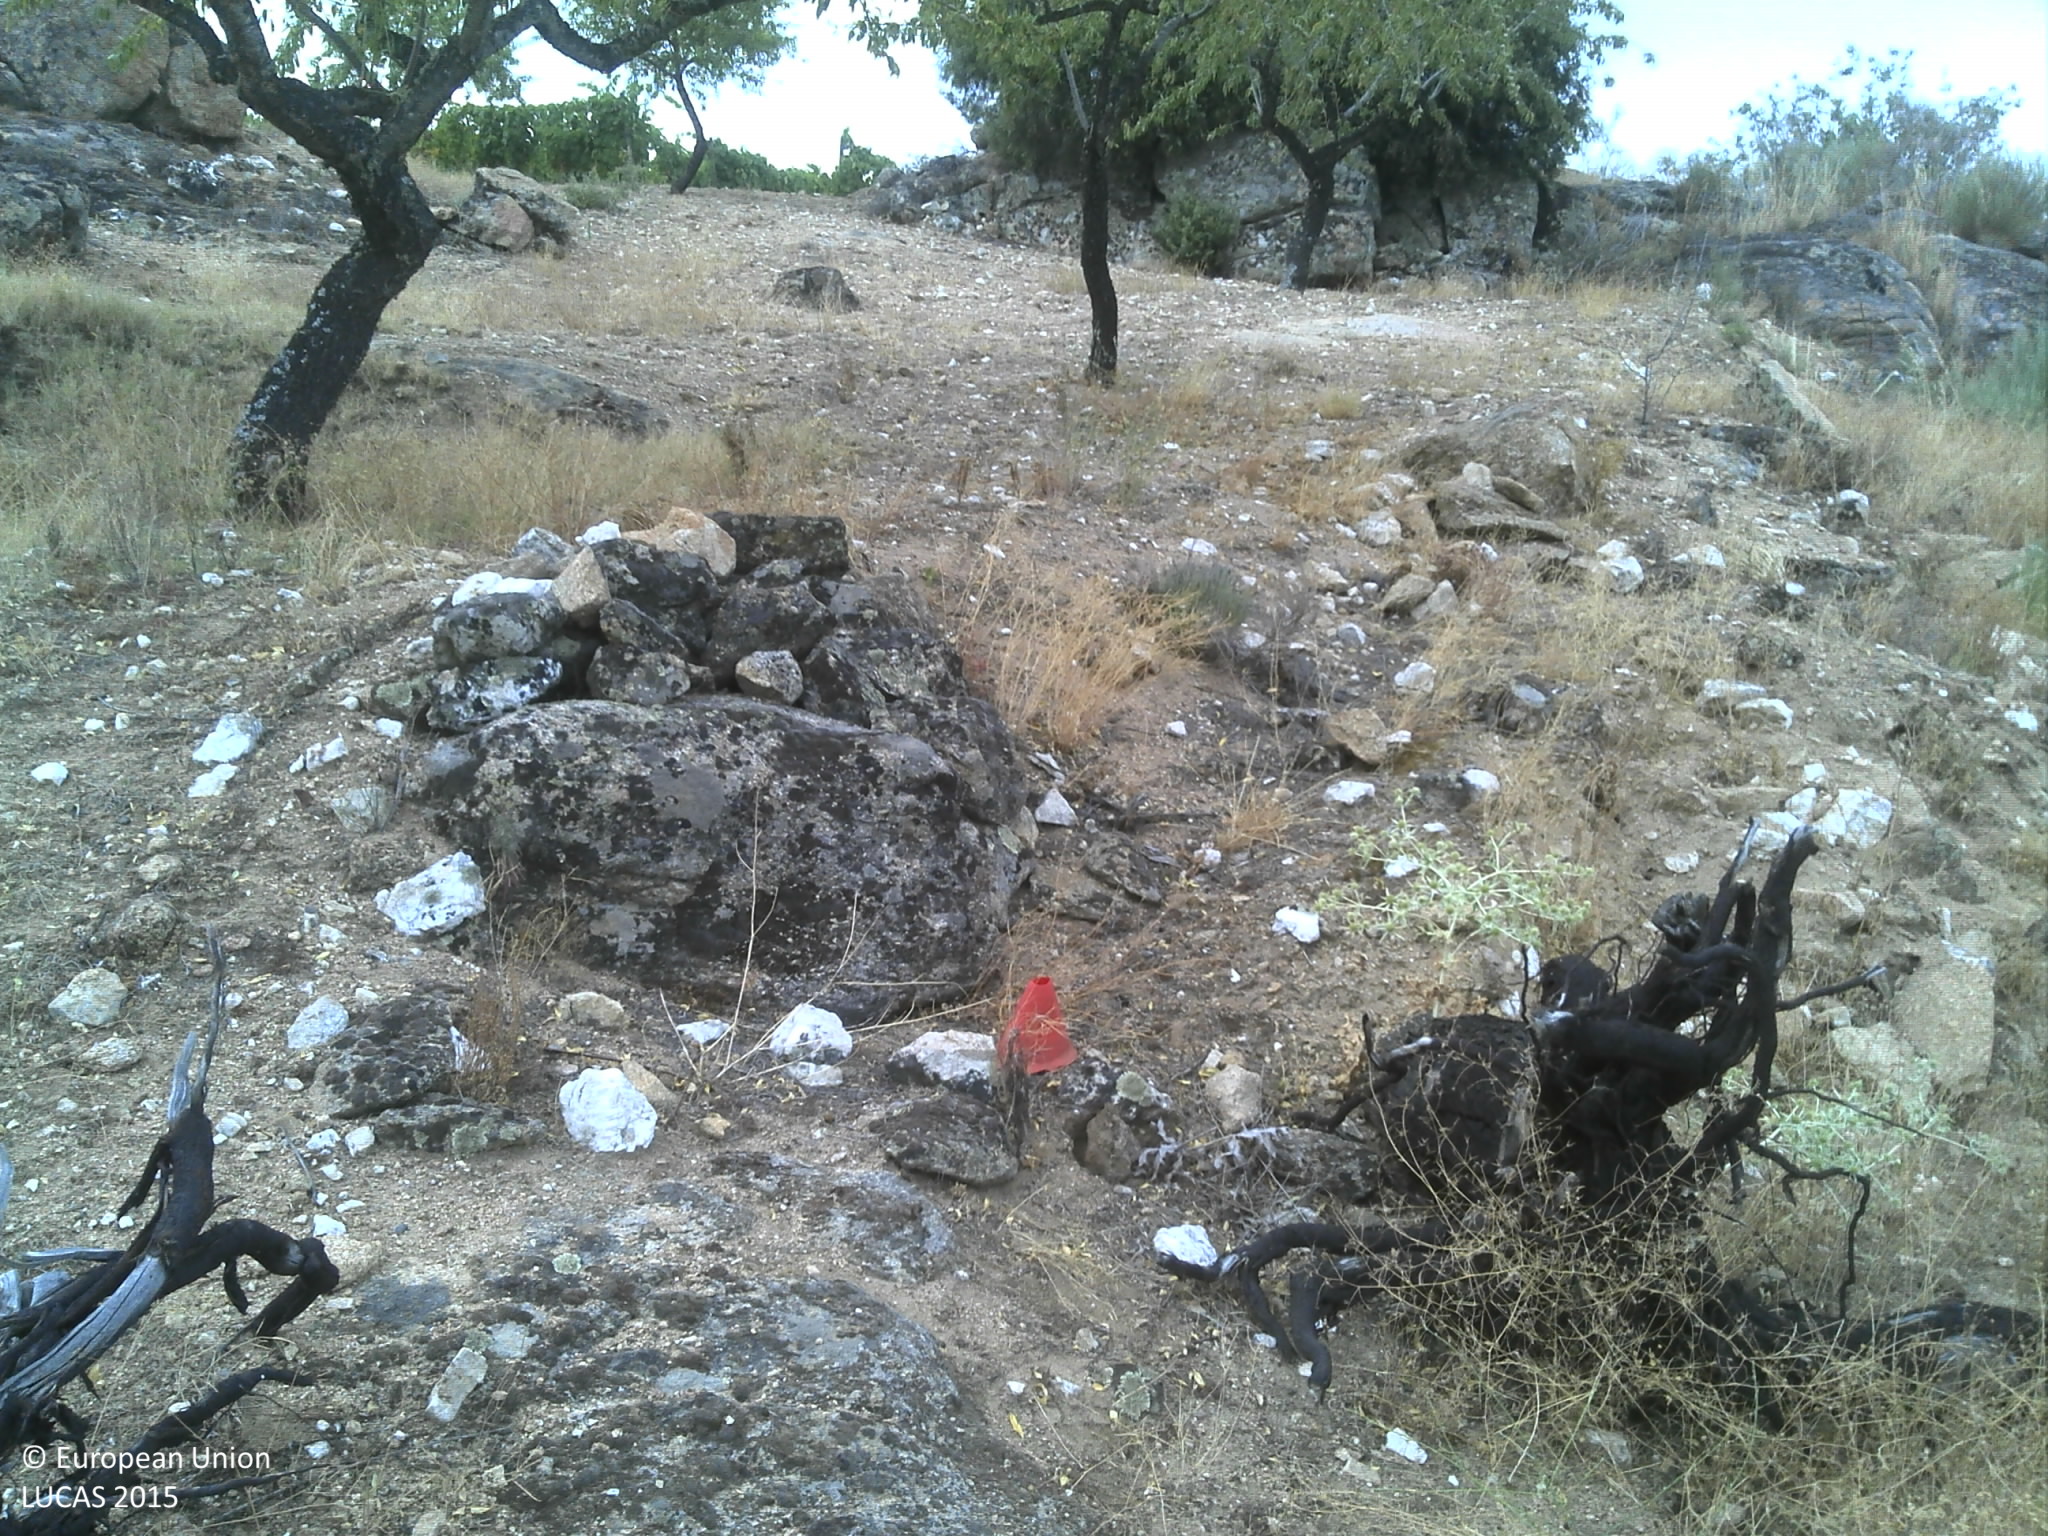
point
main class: Cropland
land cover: Nuts trees
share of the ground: 10 - 25 %
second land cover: Grassland without tree/shrub cover
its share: > 75 %
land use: Agriculture (excluding fallow land and kitchen gardens)
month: July
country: PT
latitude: 41.0880
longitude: -7.2446
